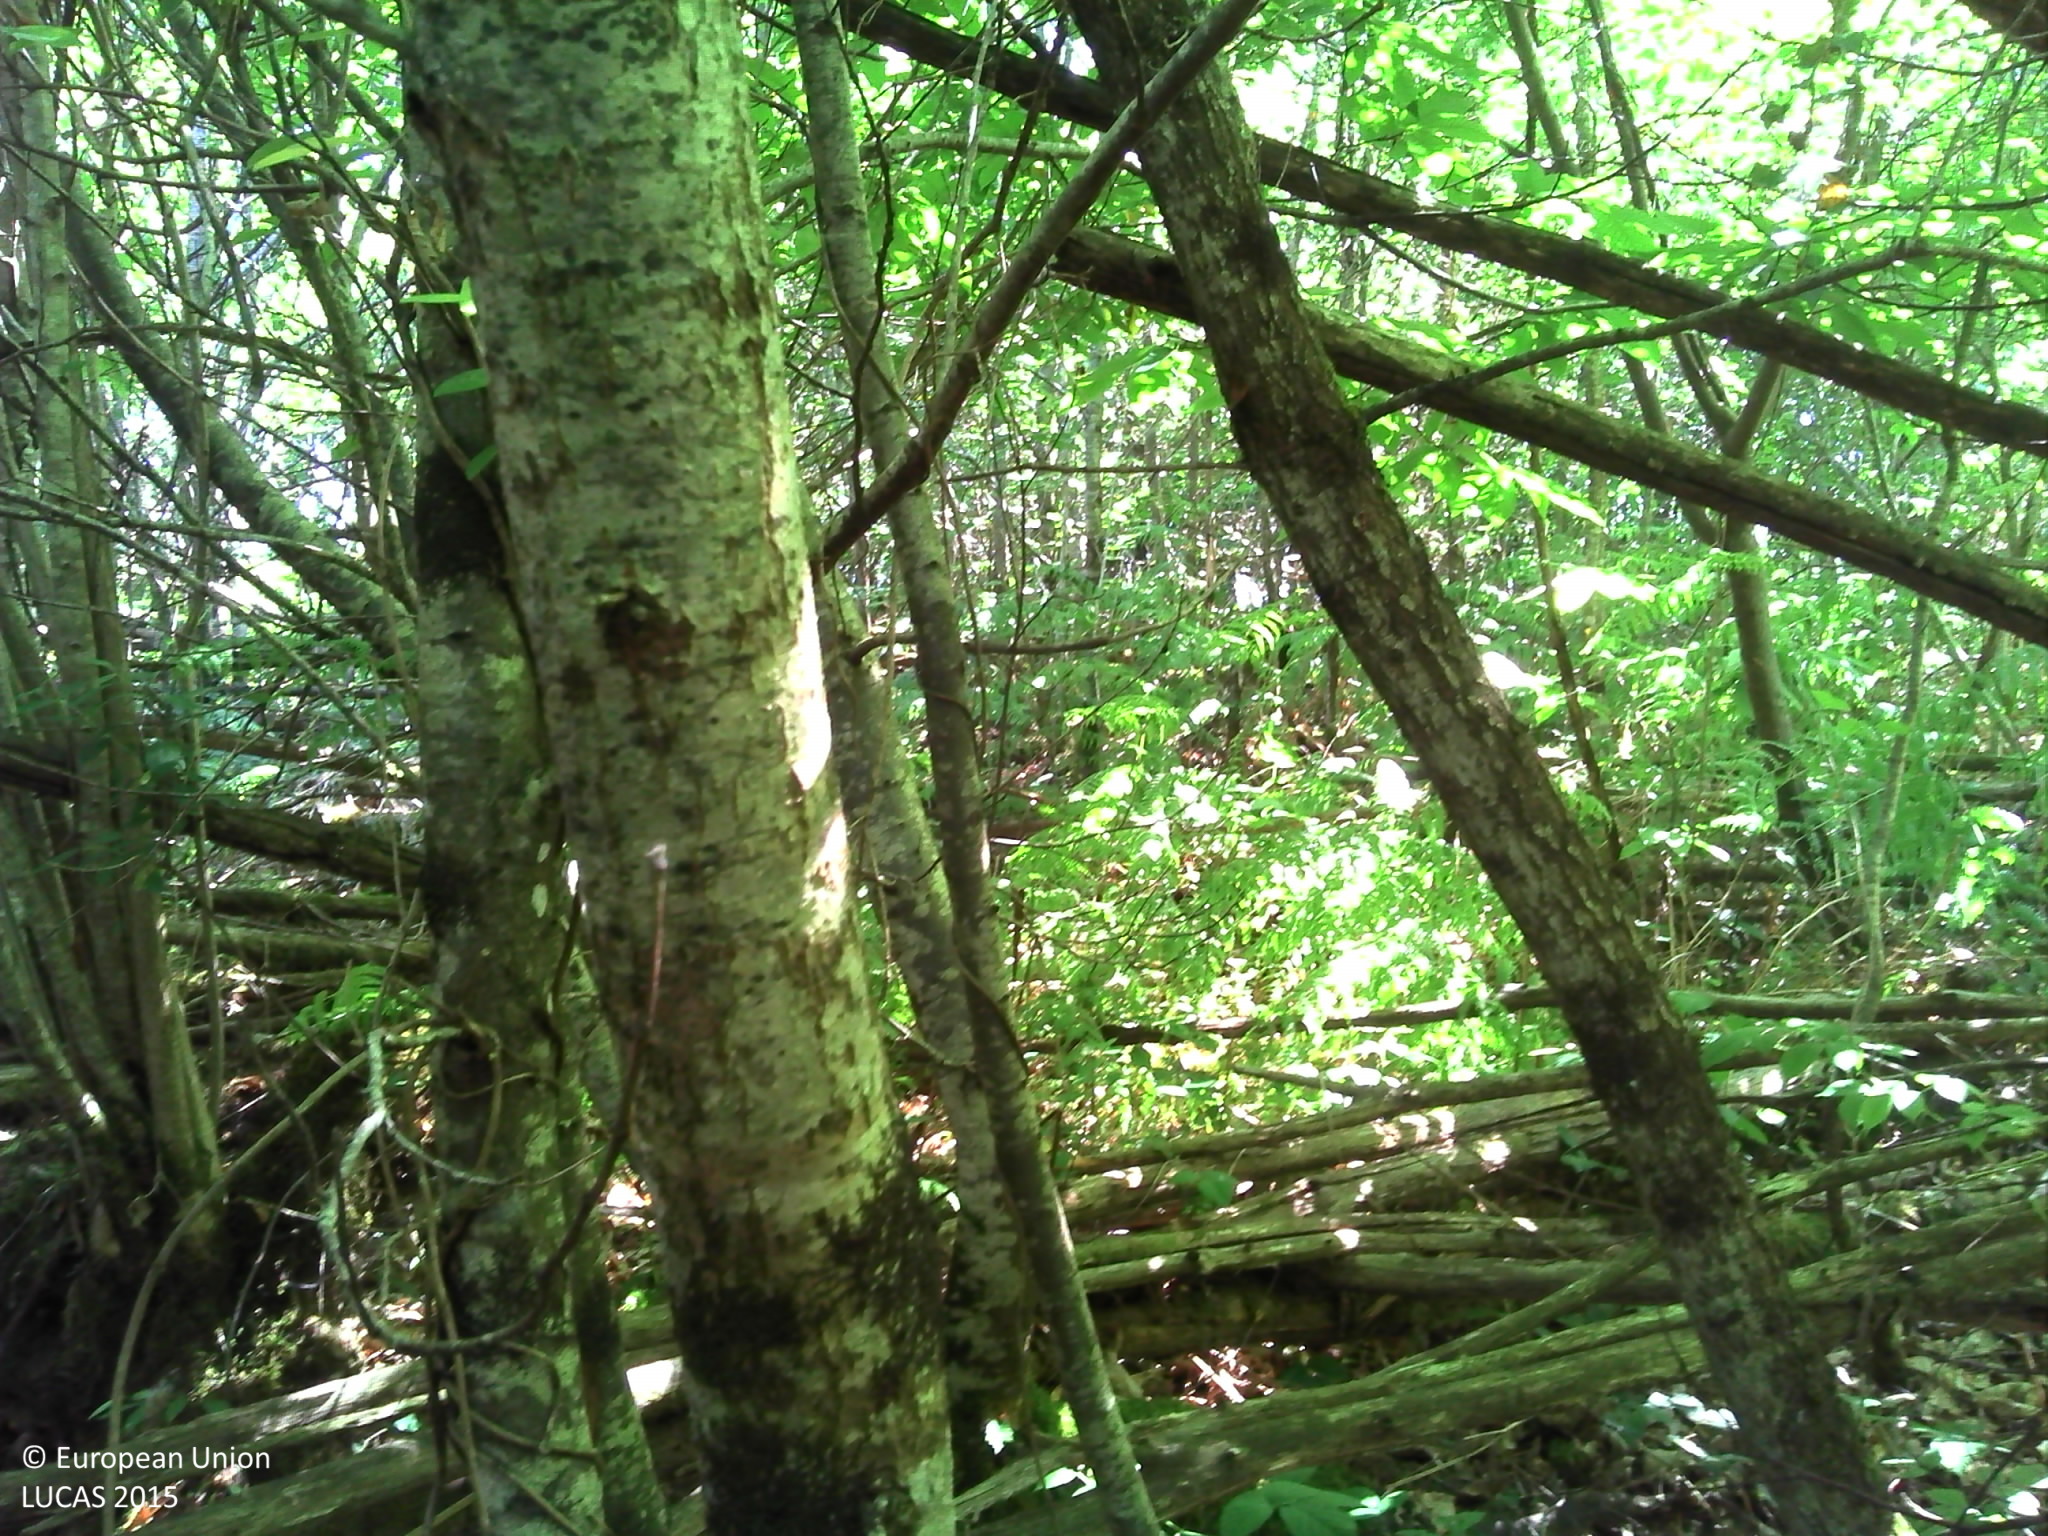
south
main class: Woodland
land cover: Broadleaved woodland
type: thermophilous deciduous forest
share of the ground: > 75 %
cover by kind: broadleaved forest trees 80 %, shrubs 15 %, herbaceous plants 5 %
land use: Semi-natural and natural areas not in use
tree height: > 5 m
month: June
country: FR
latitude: 45.7610
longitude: 0.6656
